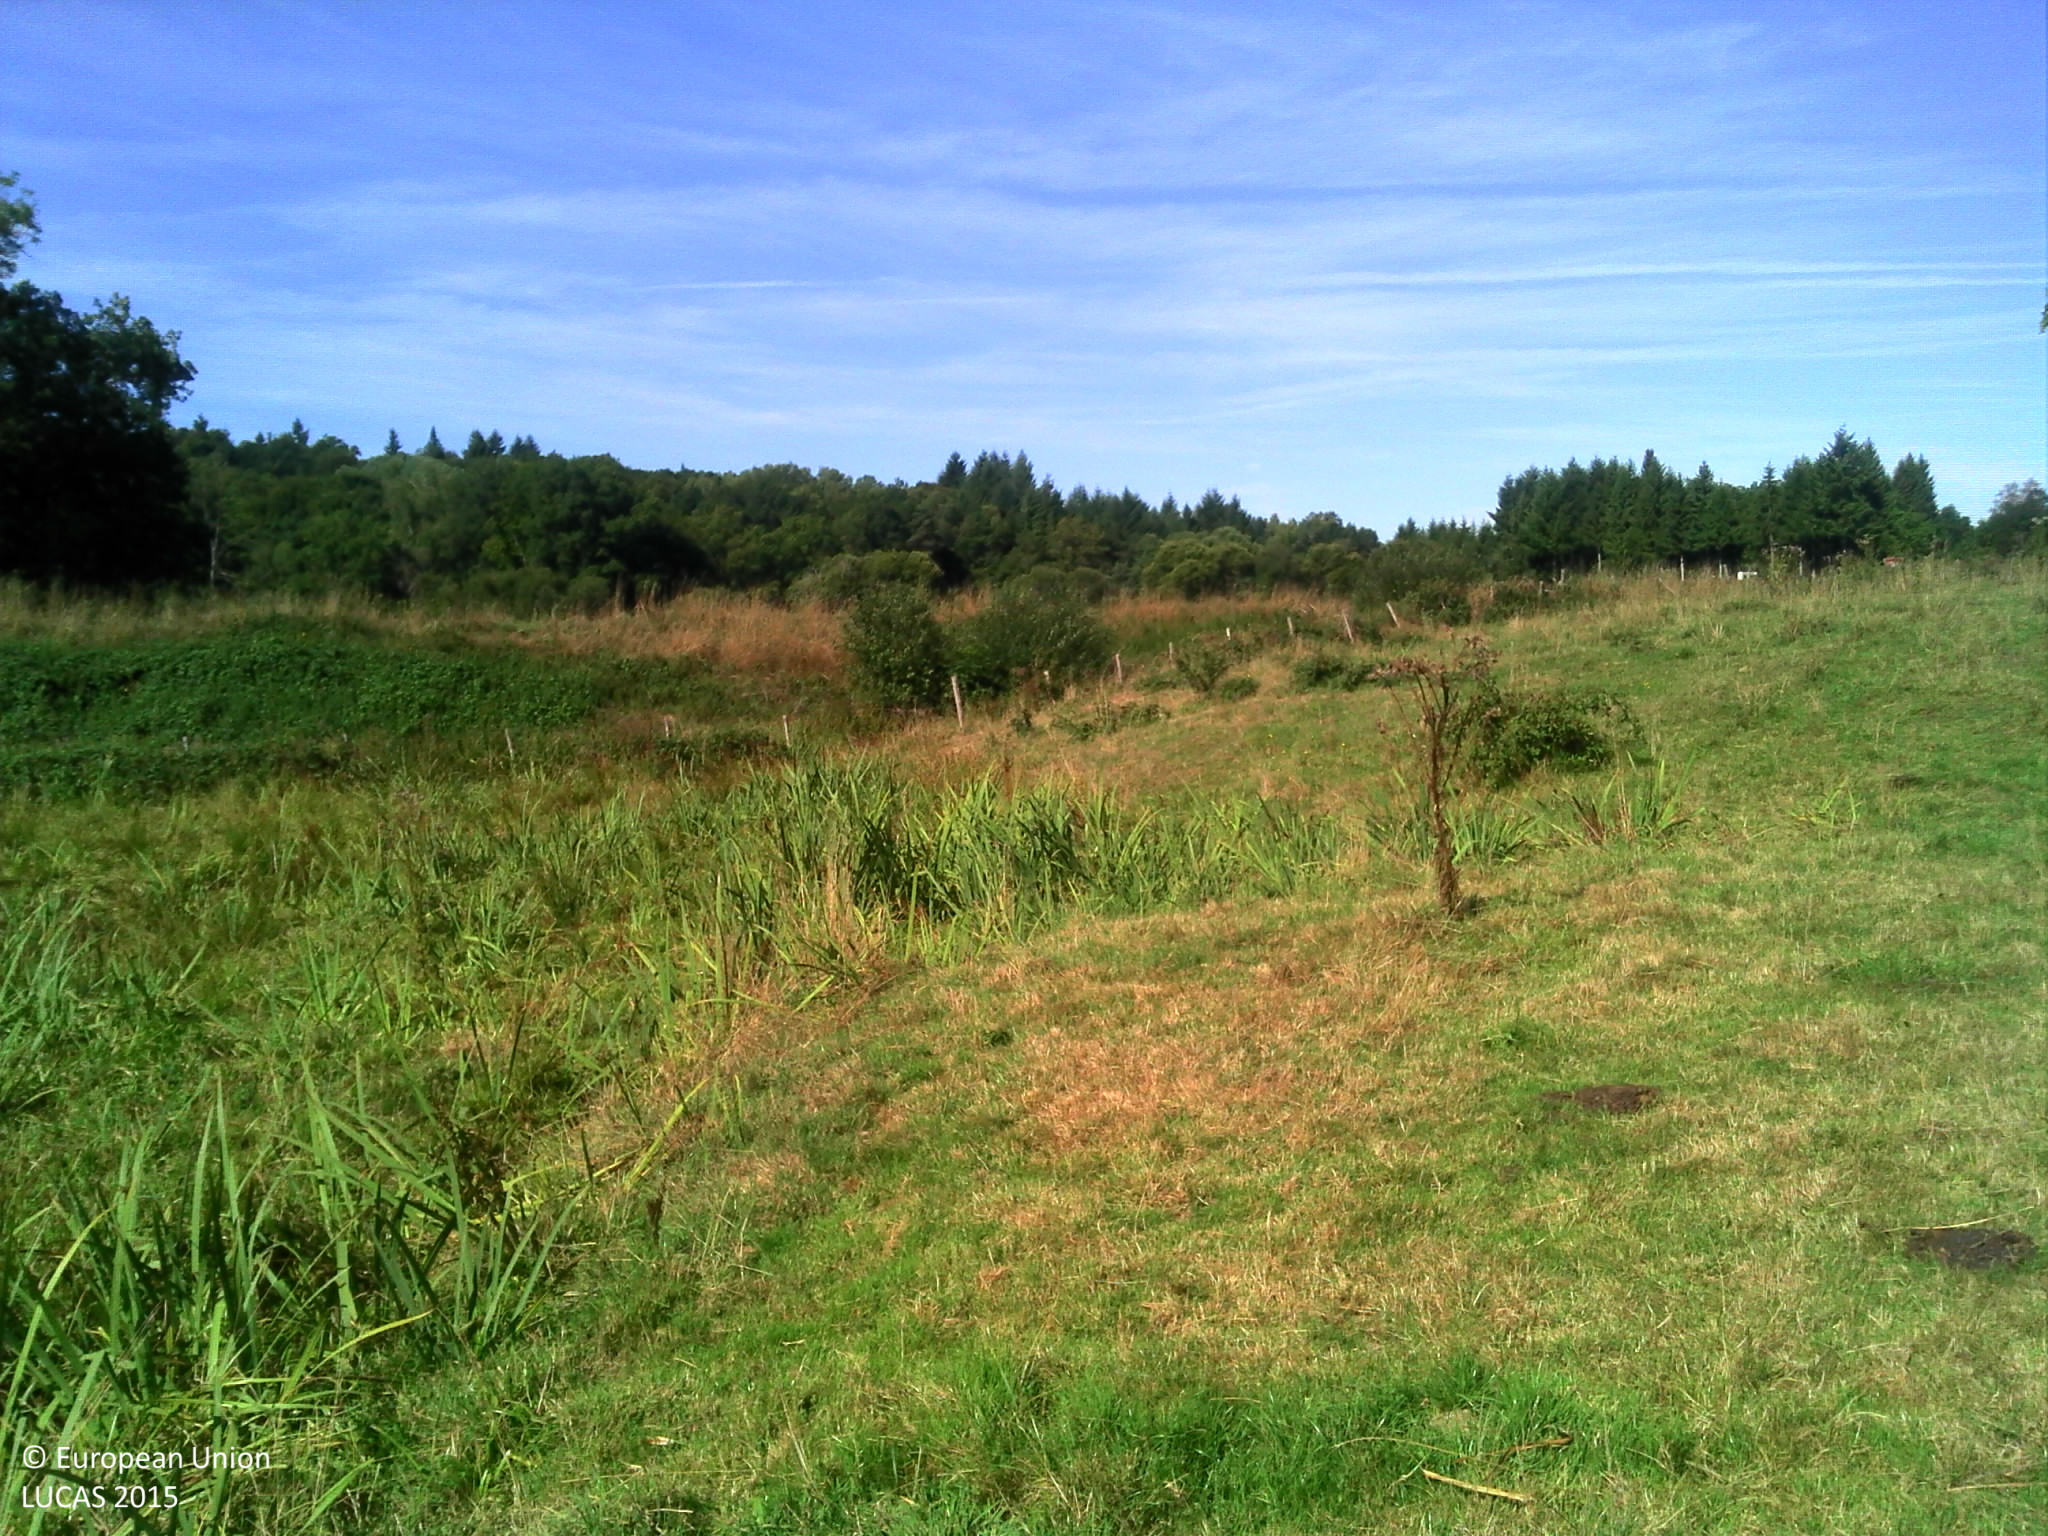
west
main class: Grassland
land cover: Grassland without tree/shrub cover
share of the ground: > 75 %
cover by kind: herbaceous plants 95 %, shrubs 5 %
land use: Agriculture (excluding fallow land and kitchen gardens)
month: August
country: FR
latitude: 45.9143
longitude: 2.3511
